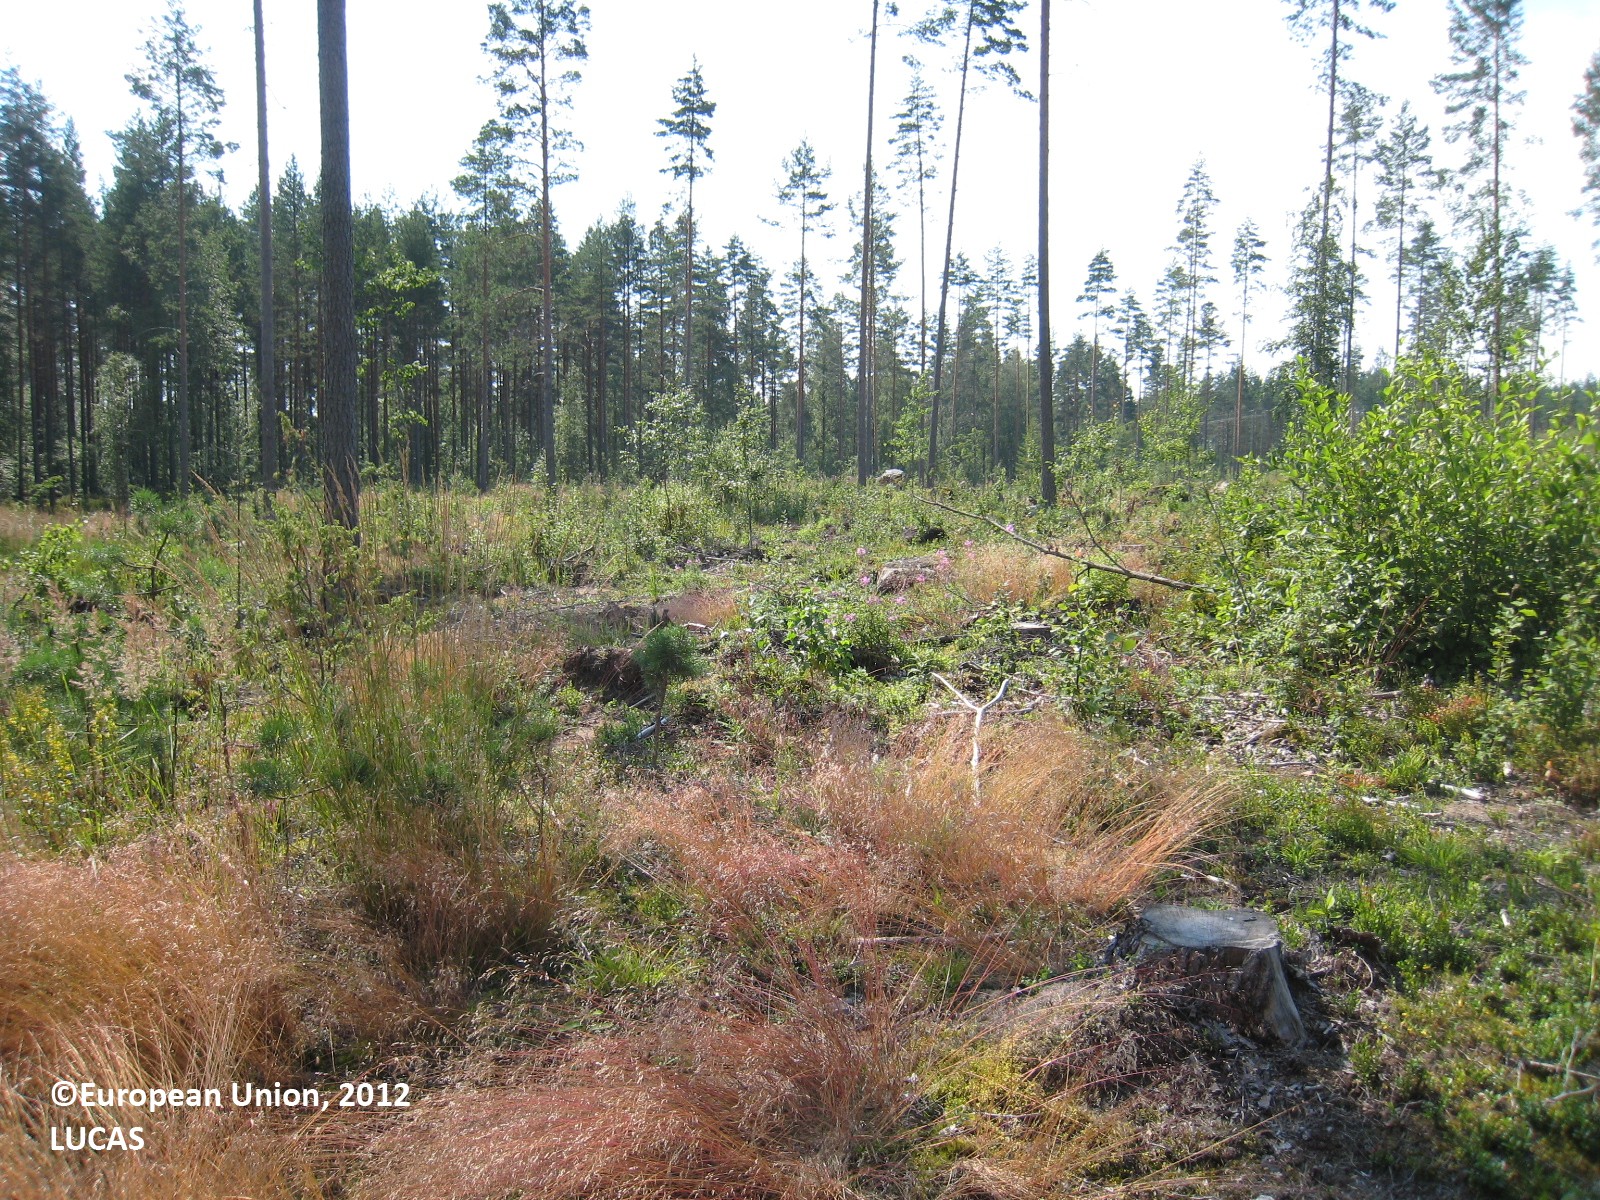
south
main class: Shrubland
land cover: Shrubland with sparse tree cover
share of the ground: > 75 %
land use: Forestry
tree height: > 5 m
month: July
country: FI
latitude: 61.7511
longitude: 26.1391
